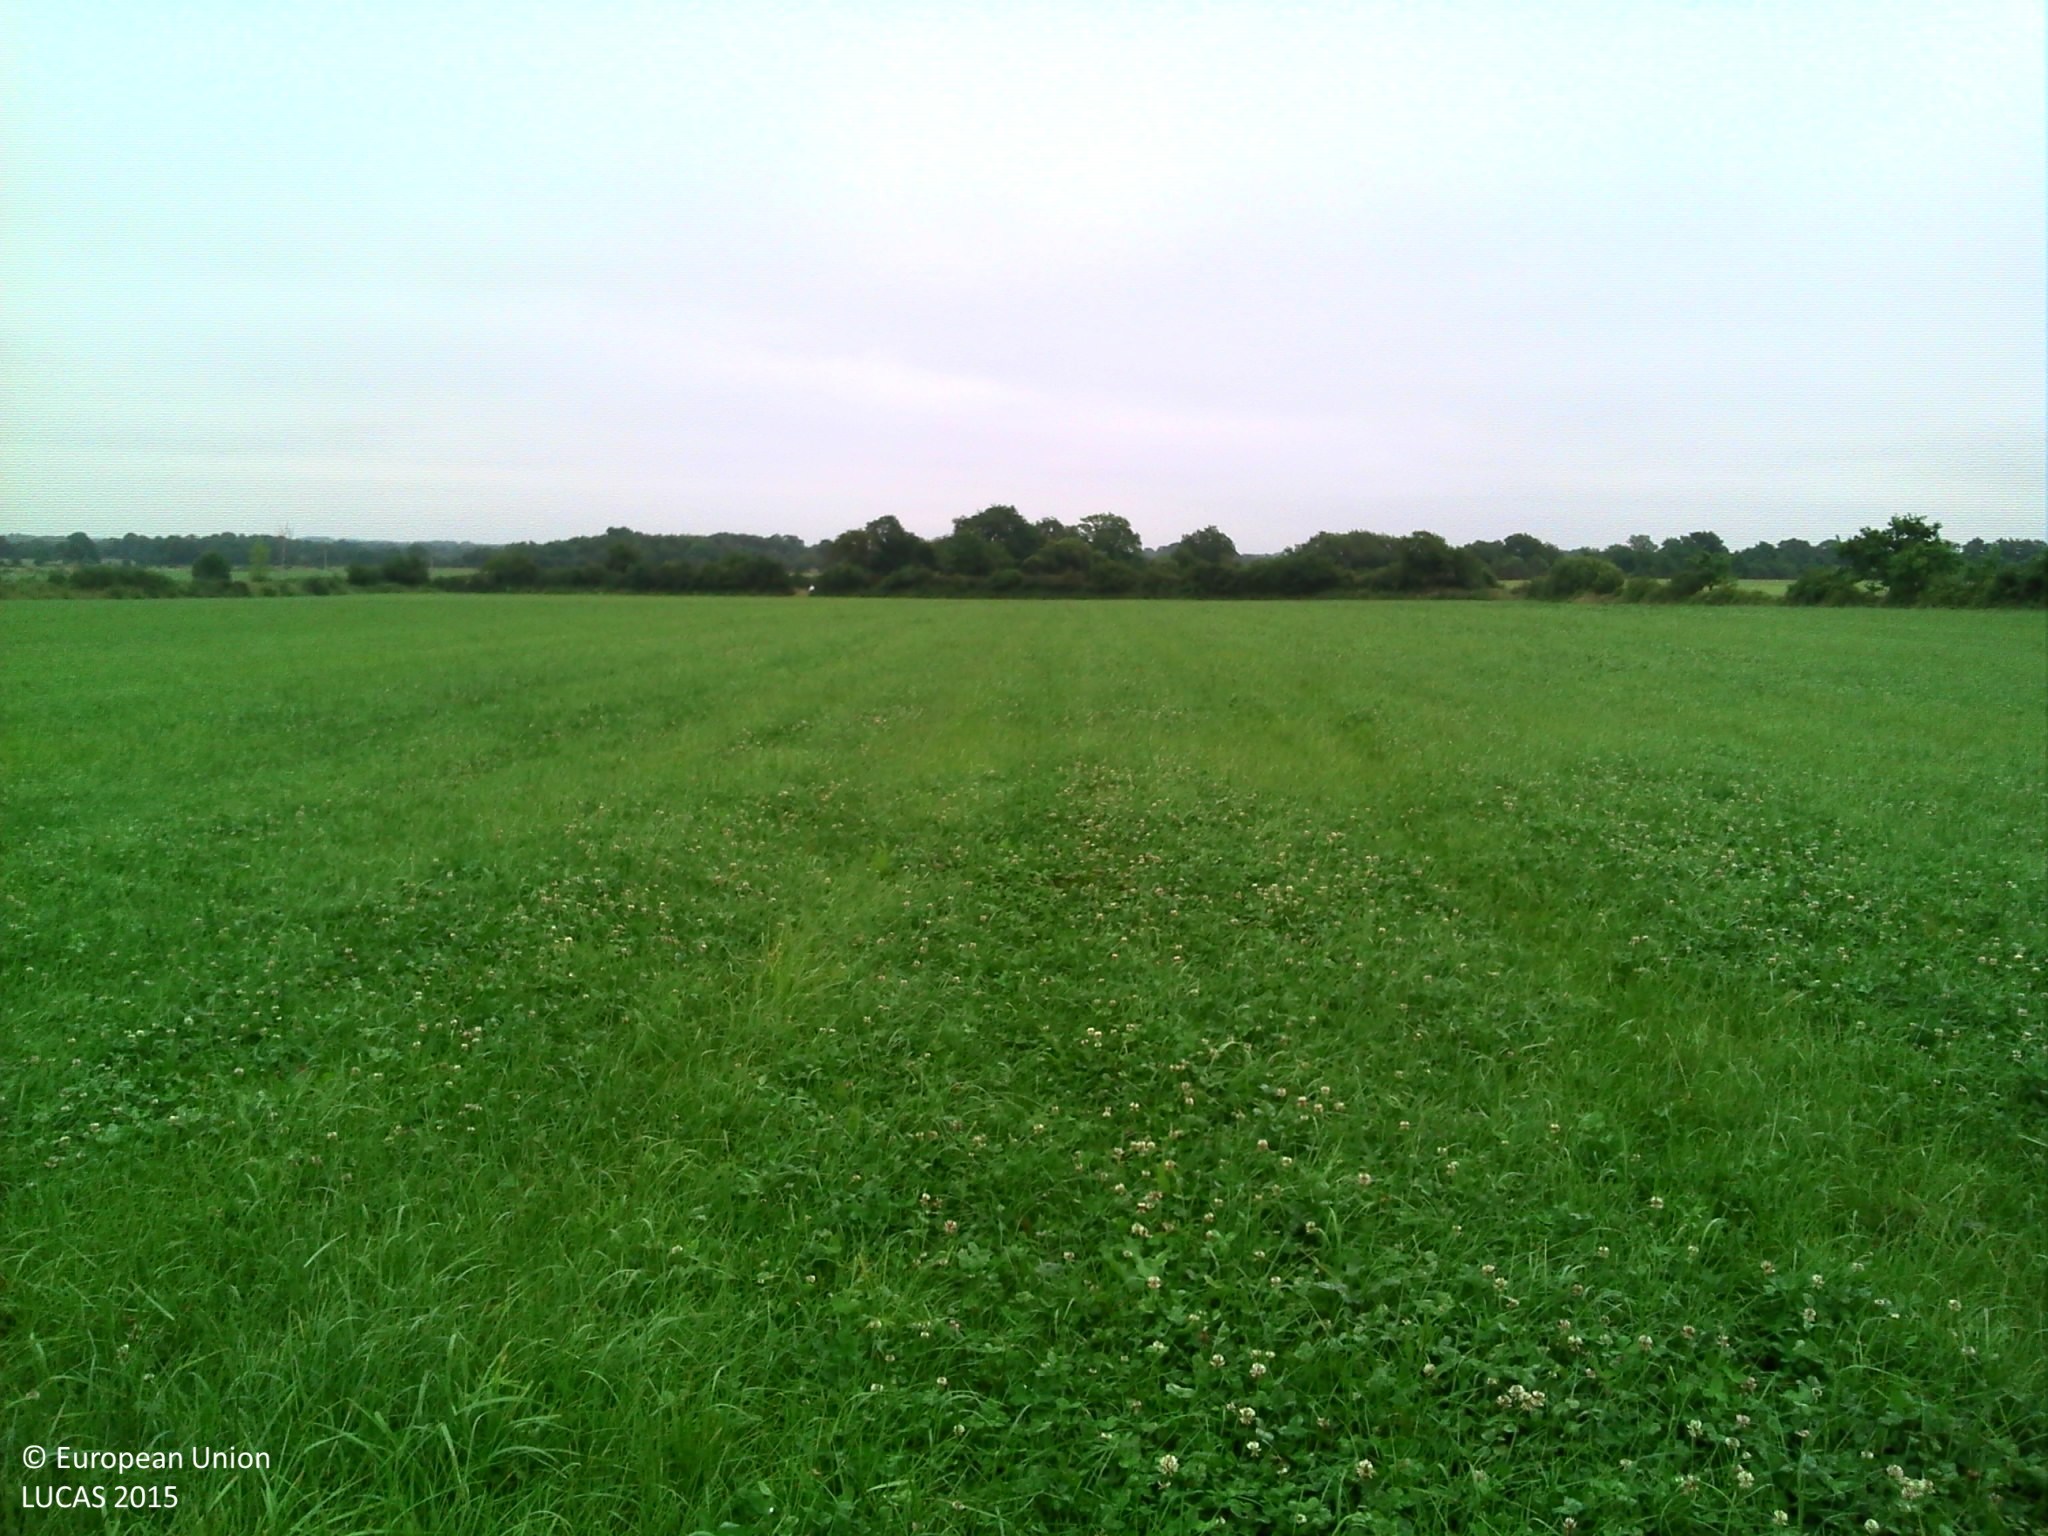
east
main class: Cropland
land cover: Temporary grasslands
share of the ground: > 75 %
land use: Agriculture (excluding fallow land and kitchen gardens)
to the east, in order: Temporary grasslands; Fences; Abandoned hedges; Ditches and canals; Tracks
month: June
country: FR
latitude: 47.1105
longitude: -2.0003
